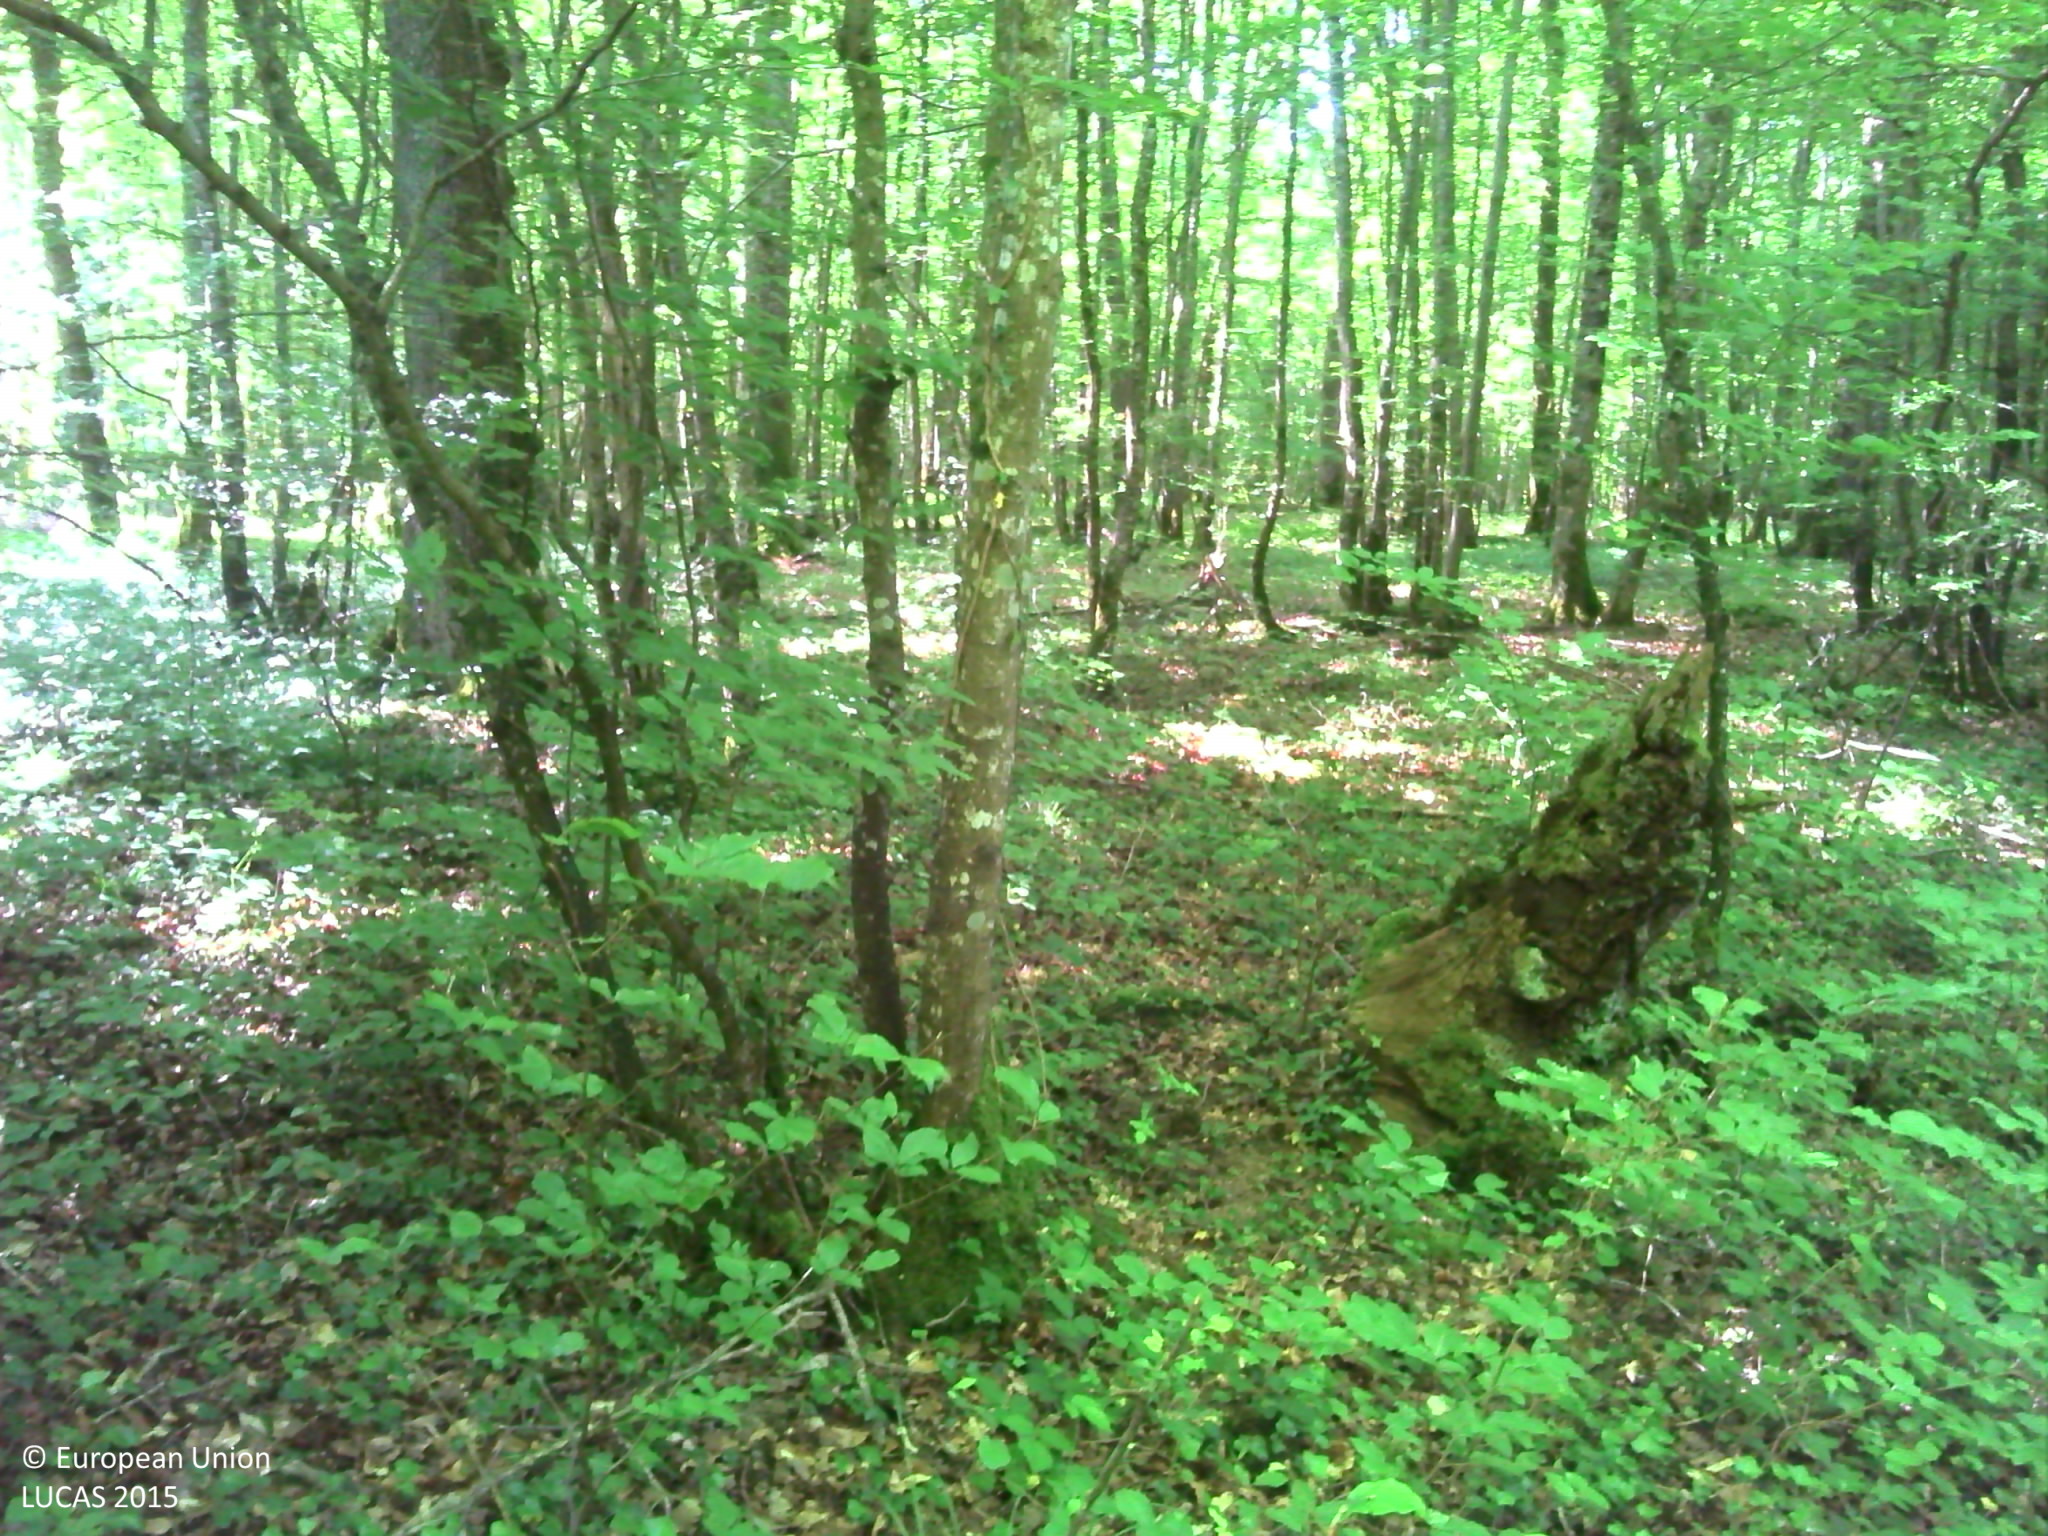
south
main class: Woodland
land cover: Broadleaved woodland
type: acidophilous oak and oak-birch forest
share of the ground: > 75 %
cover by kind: broadleaved forest trees 90 %, herbaceous plants 5 %, lichens and mosses 5 %
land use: Forestry
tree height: > 5 m
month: June
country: FR
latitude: 47.6239
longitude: 3.9429
